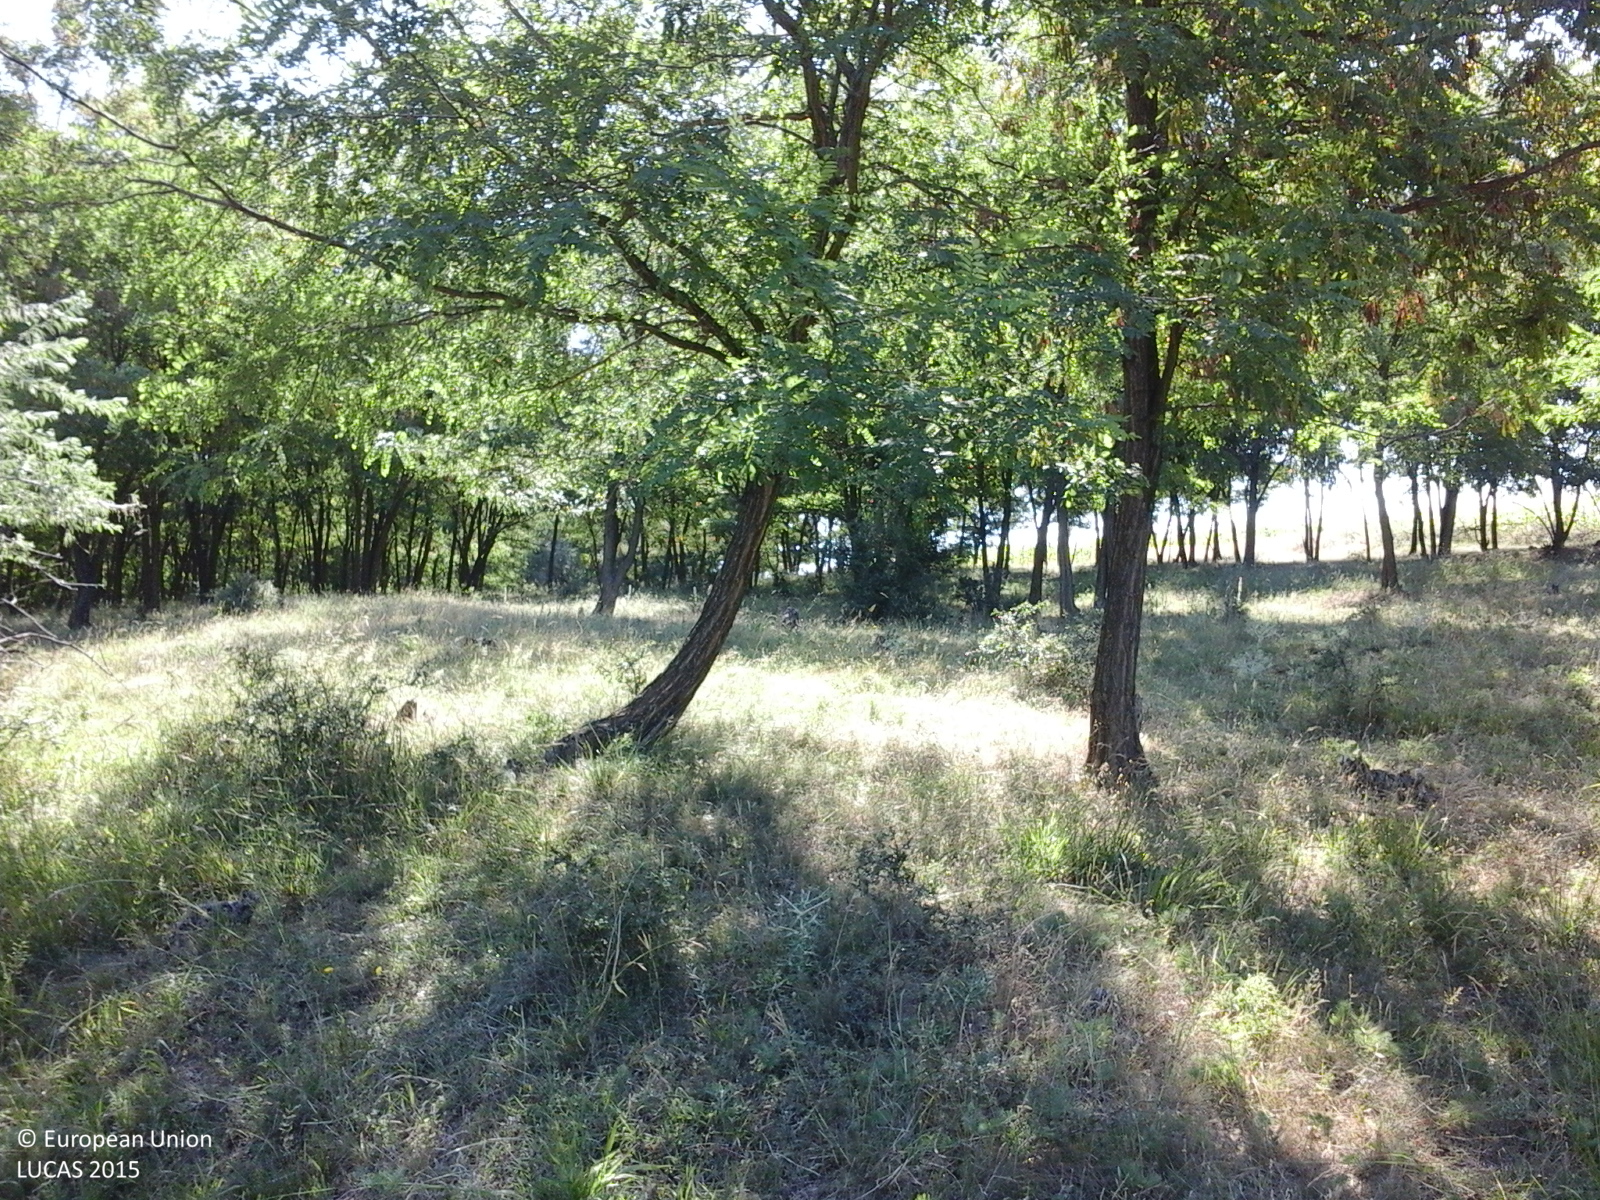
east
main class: Woodland
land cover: Broadleaved woodland
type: exotic forest
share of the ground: > 75 %
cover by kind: broadleaved forest trees 100 %
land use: Forestry
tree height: > 5 m
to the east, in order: Broadleaved woodland; Tracks; Maize
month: July
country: RO
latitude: 46.0305
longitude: 27.7497
